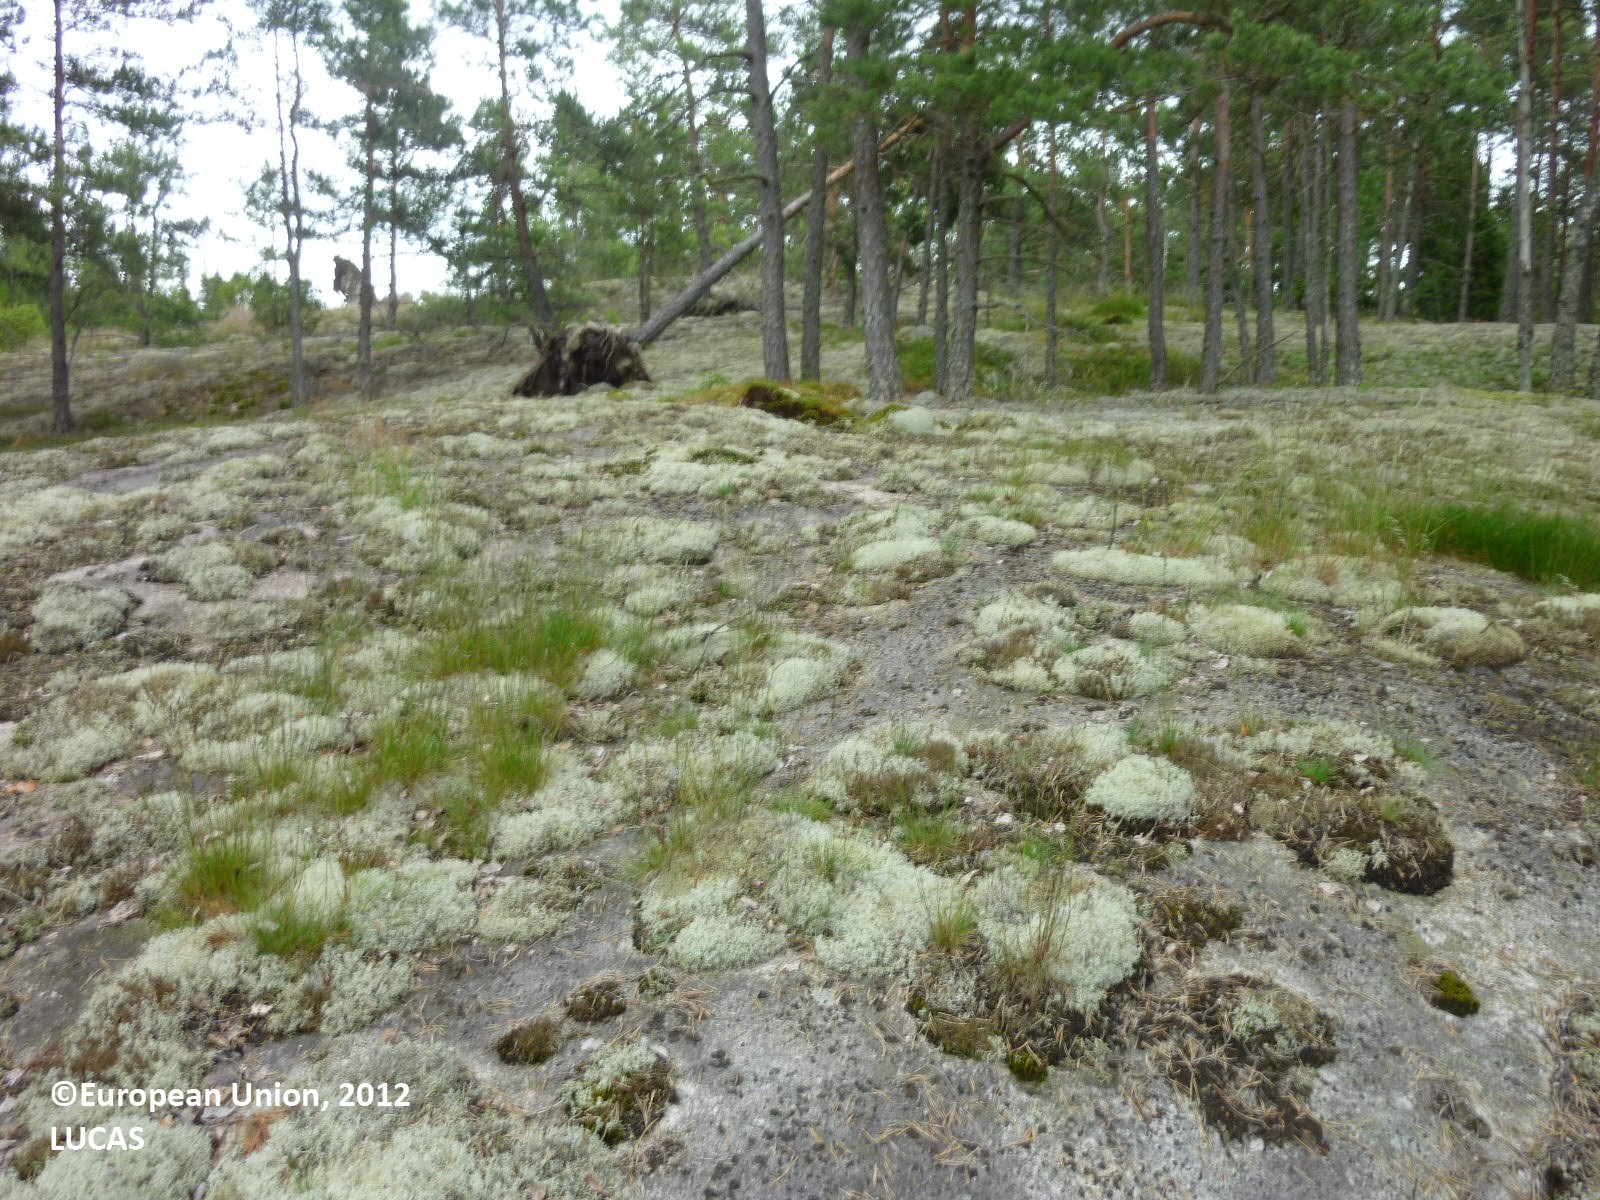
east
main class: Woodland
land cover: Pine dominated coniferous woodland
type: boreal forest
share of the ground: 10 - 25 %
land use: Forestry
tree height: > 5 m
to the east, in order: Pine dominated coniferous woodland; Rocks and stones; Pine dominated coniferous woodland; Shrubland with sparse tree cover
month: June
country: FI
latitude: 60.2798
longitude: 22.4946
